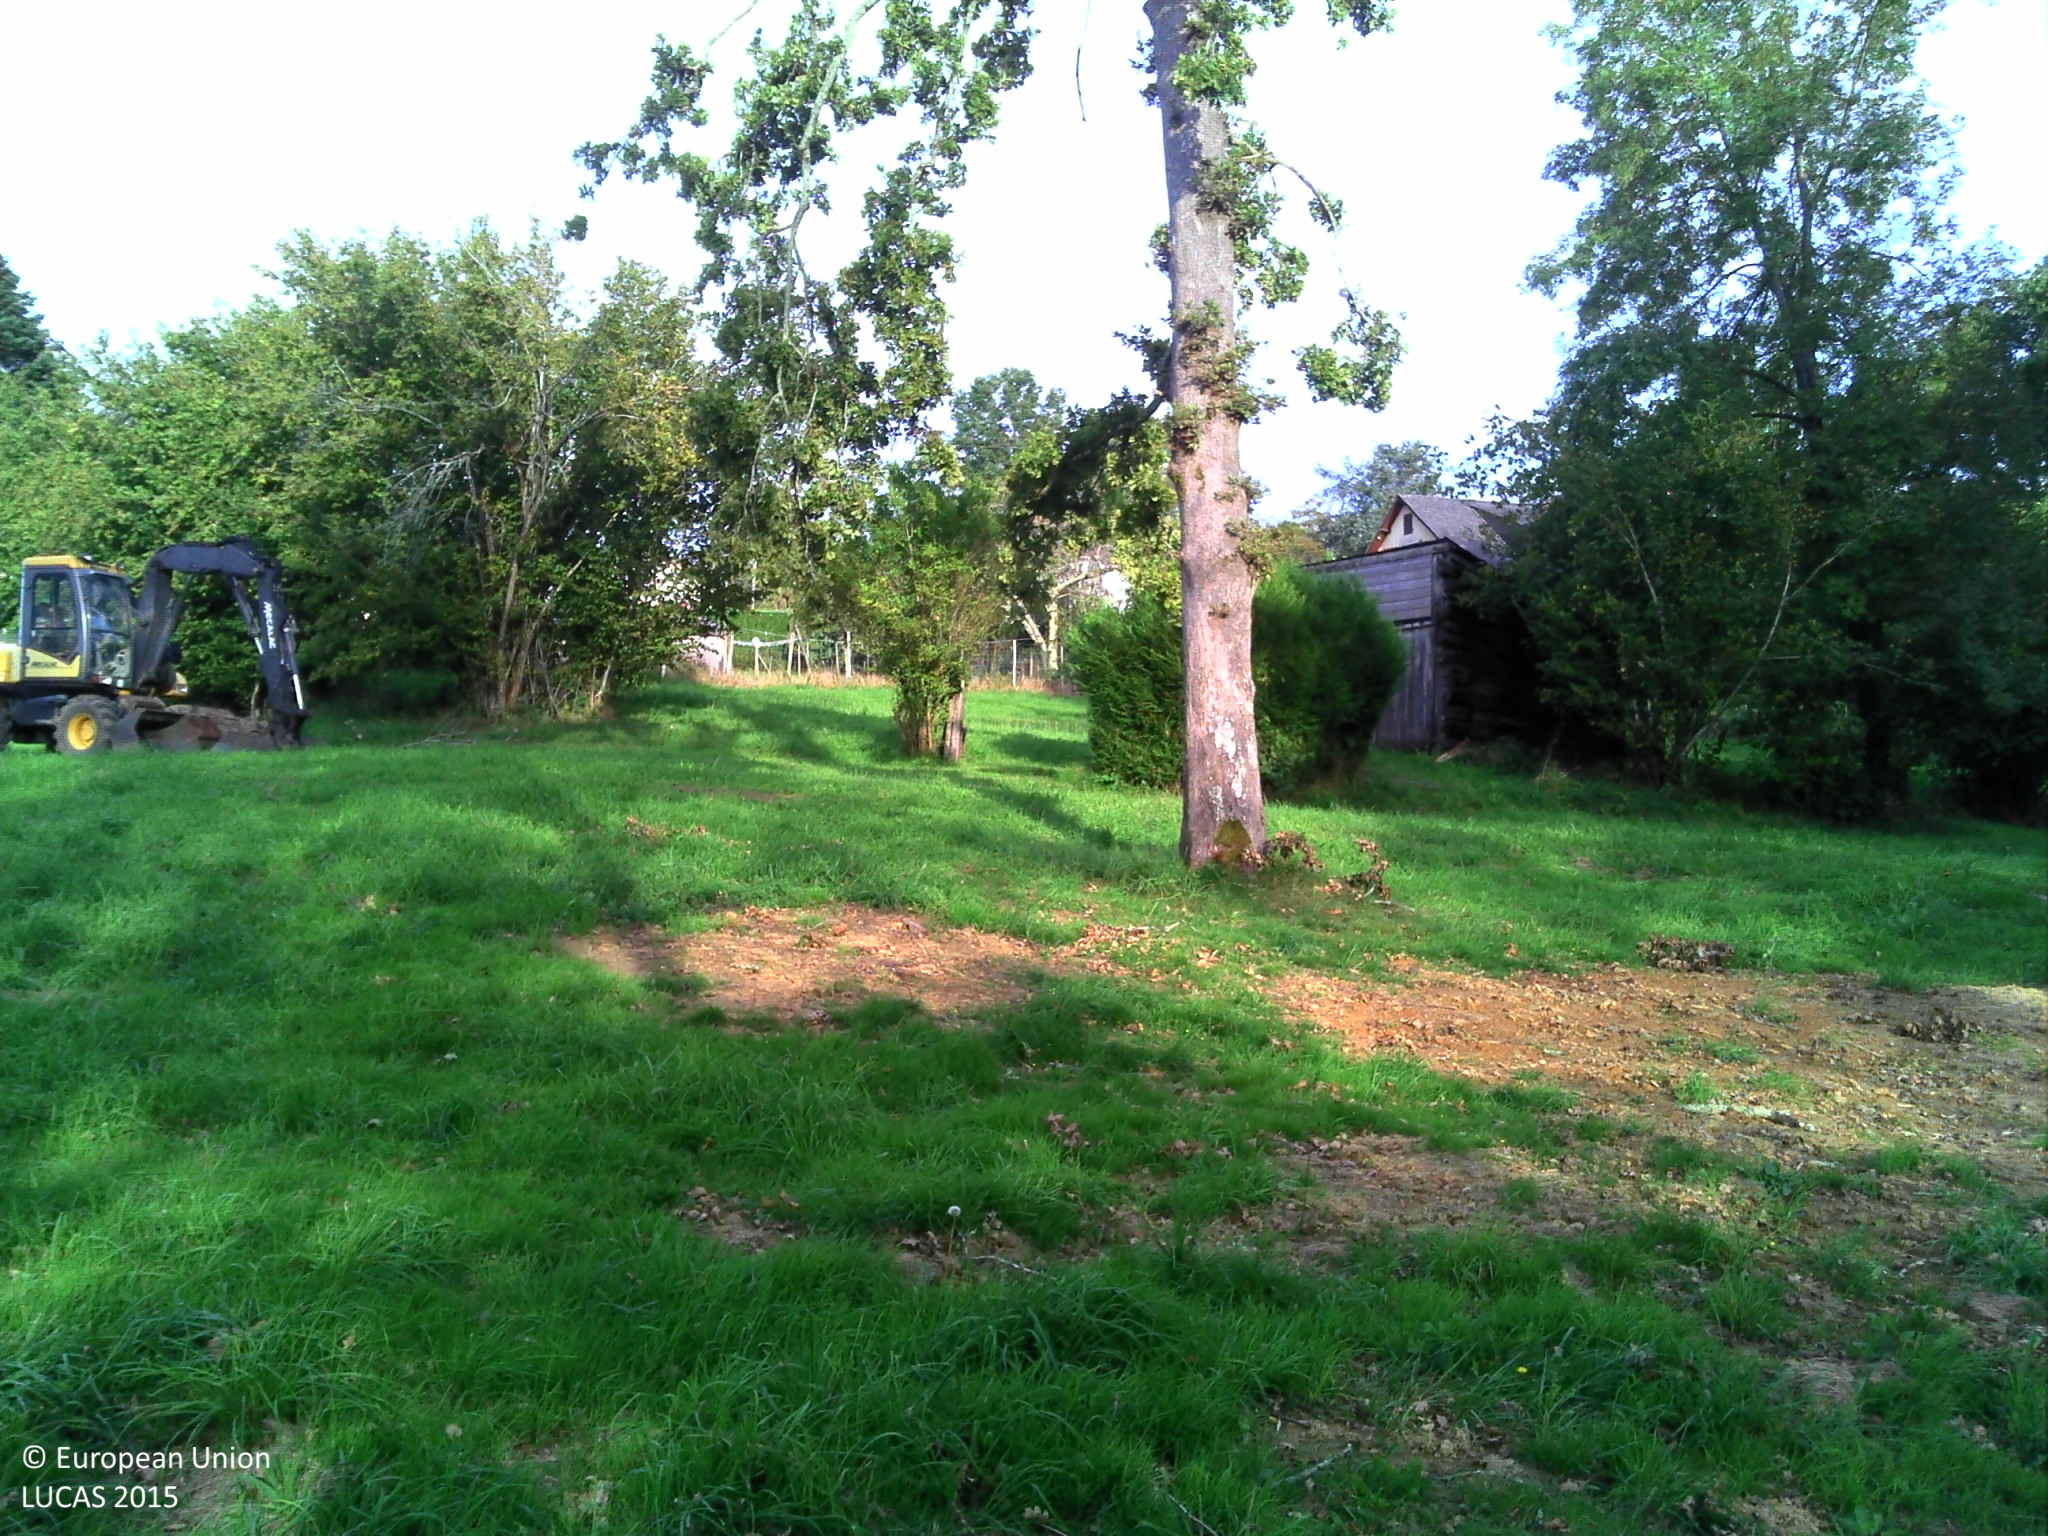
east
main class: Woodland
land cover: Broadleaved woodland
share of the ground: 10 - 25 %
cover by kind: herbaceous plants 80 %, broadleaved forest trees 15 %, unconsolidated bare surface 5 %
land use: Forestry
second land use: Amenities, museums, leisure
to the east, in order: Broadleaved woodland; Grassland without tree/shrub cover; Artificial constructions in urban areas; Broadleaved woodland; Grassland without tree/shrub cover; Broadleaved woodland
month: September
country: FR
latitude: 43.1289
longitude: -0.4672
